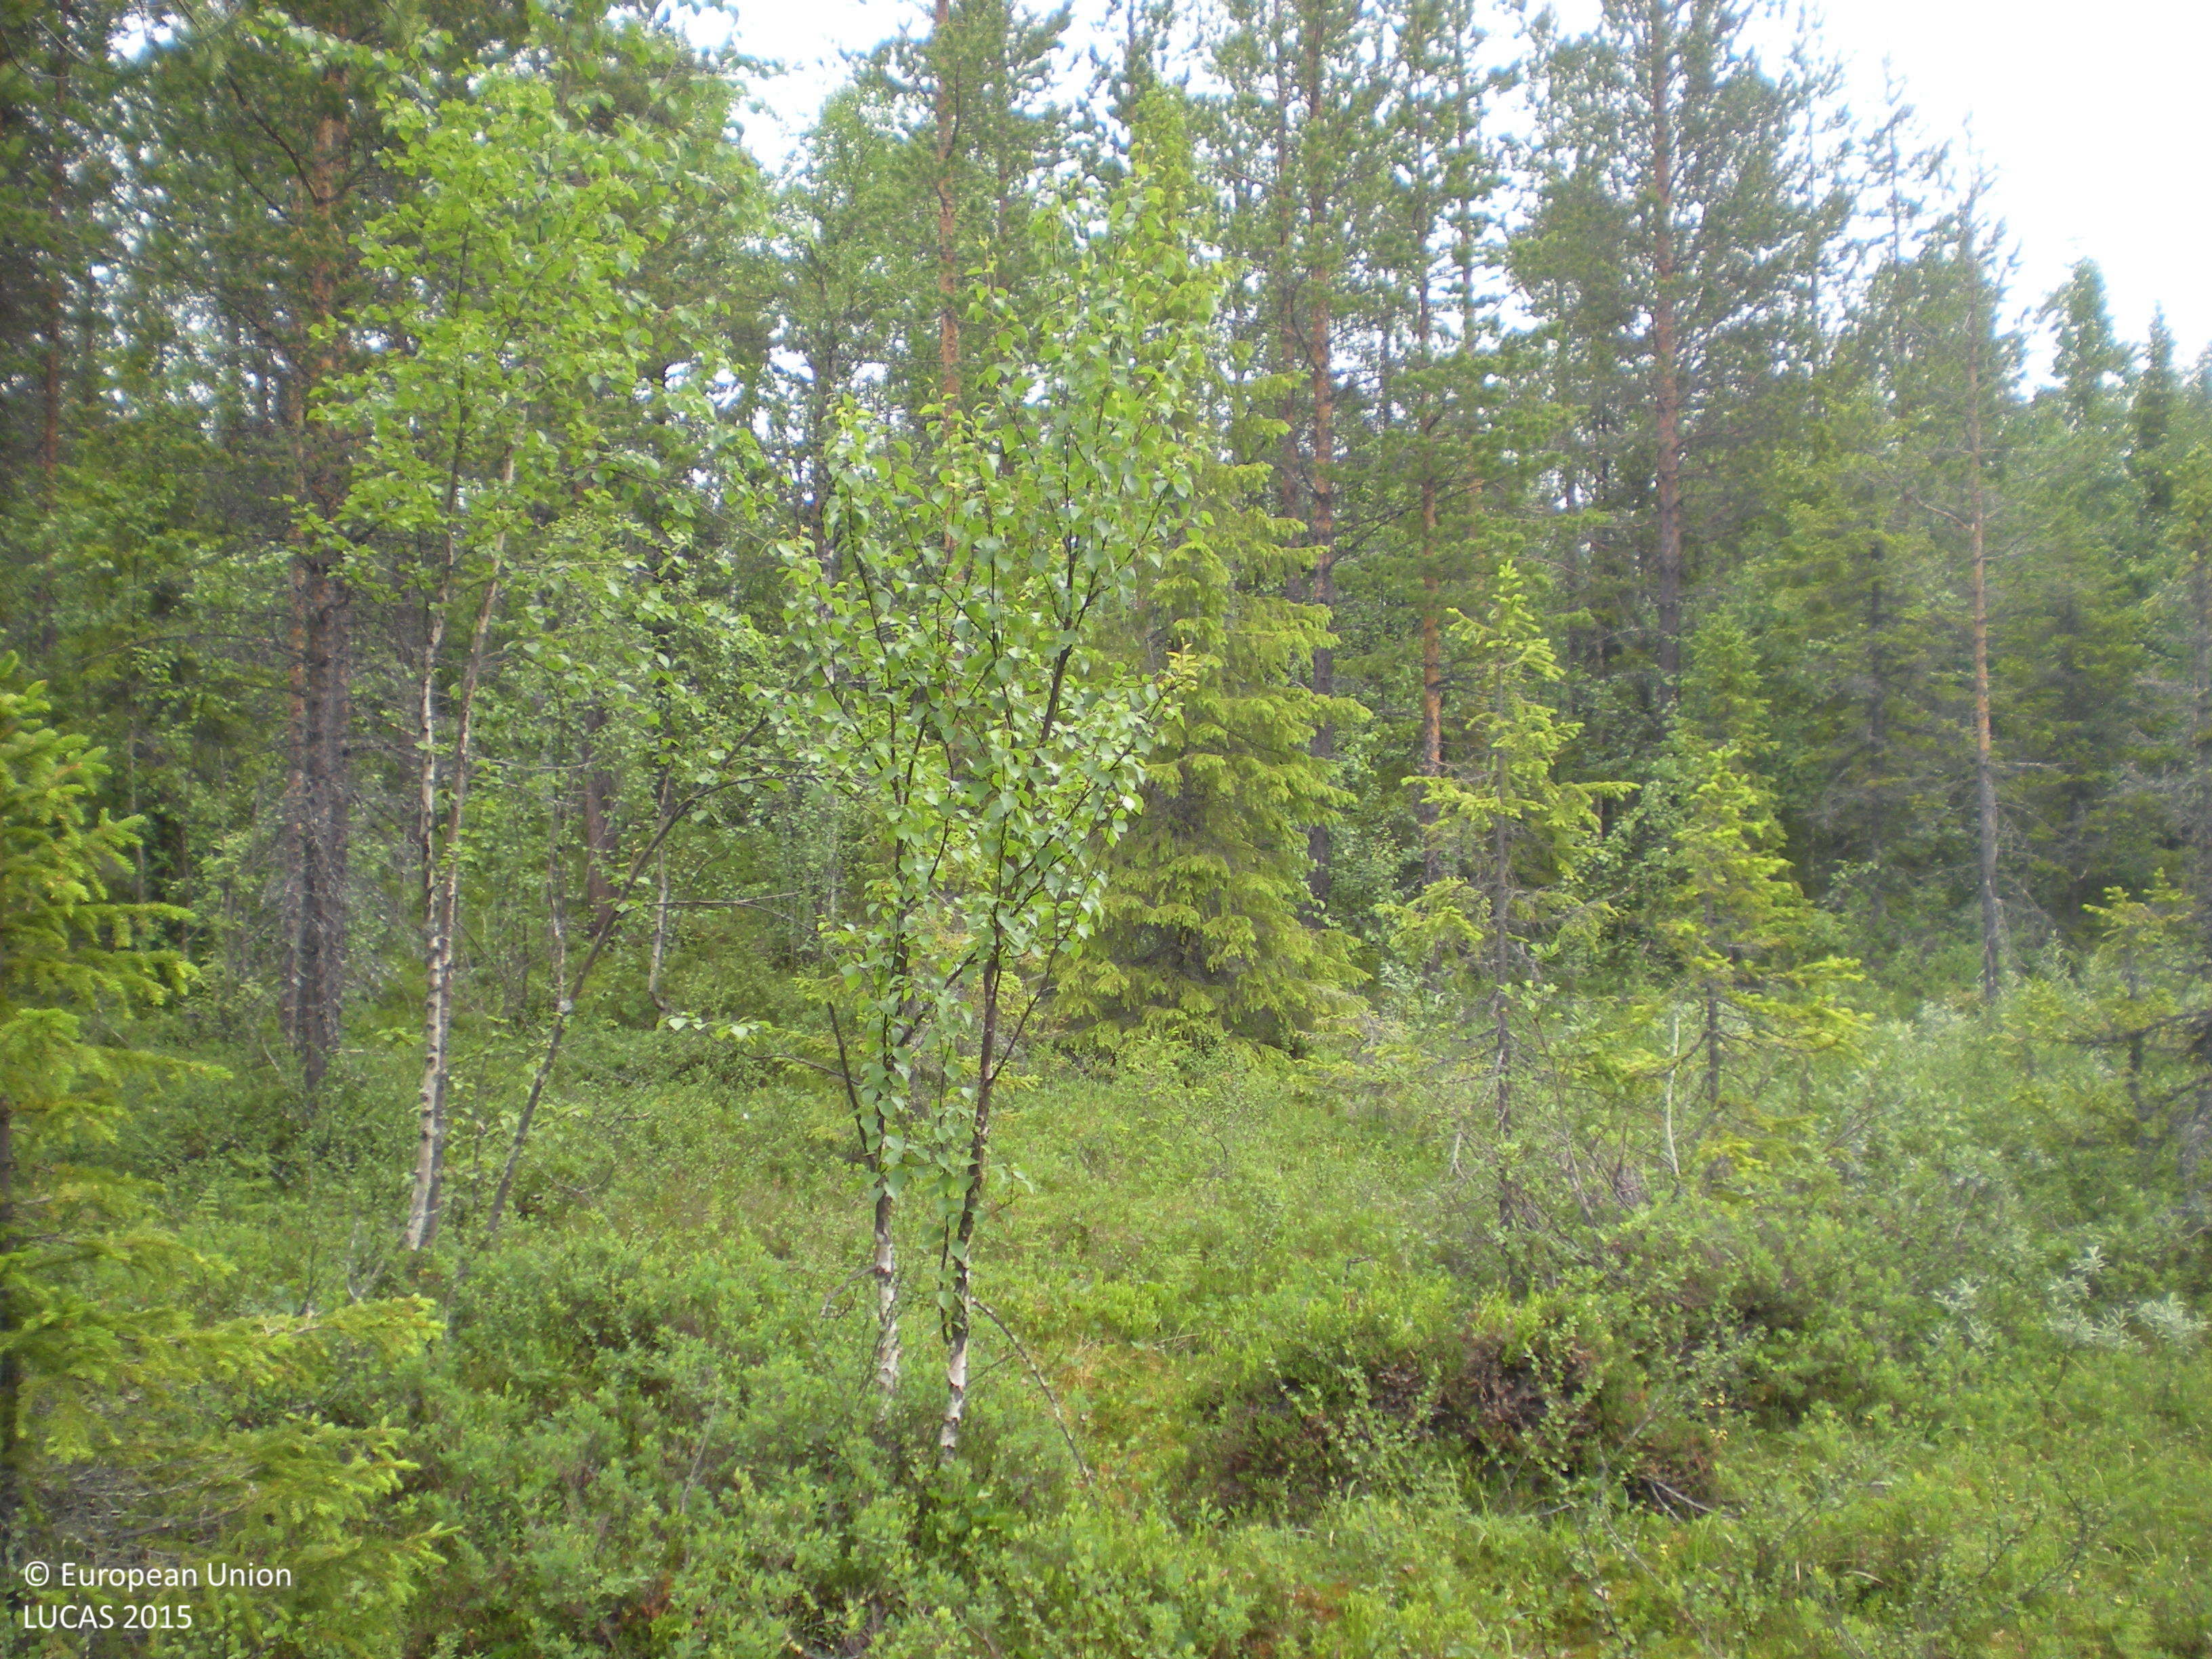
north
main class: Woodland
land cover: Other coniferous woodland
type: boreal forest
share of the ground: 50 - 75 %
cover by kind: coniferous forest trees 40 %, shrubs 25 %, lichens and mosses 20 %, broadleaved forest trees 10 %, herbaceous plants 5 %
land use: Forestry
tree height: > 5 m
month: July
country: SE
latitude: 65.5251
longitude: 17.1635
